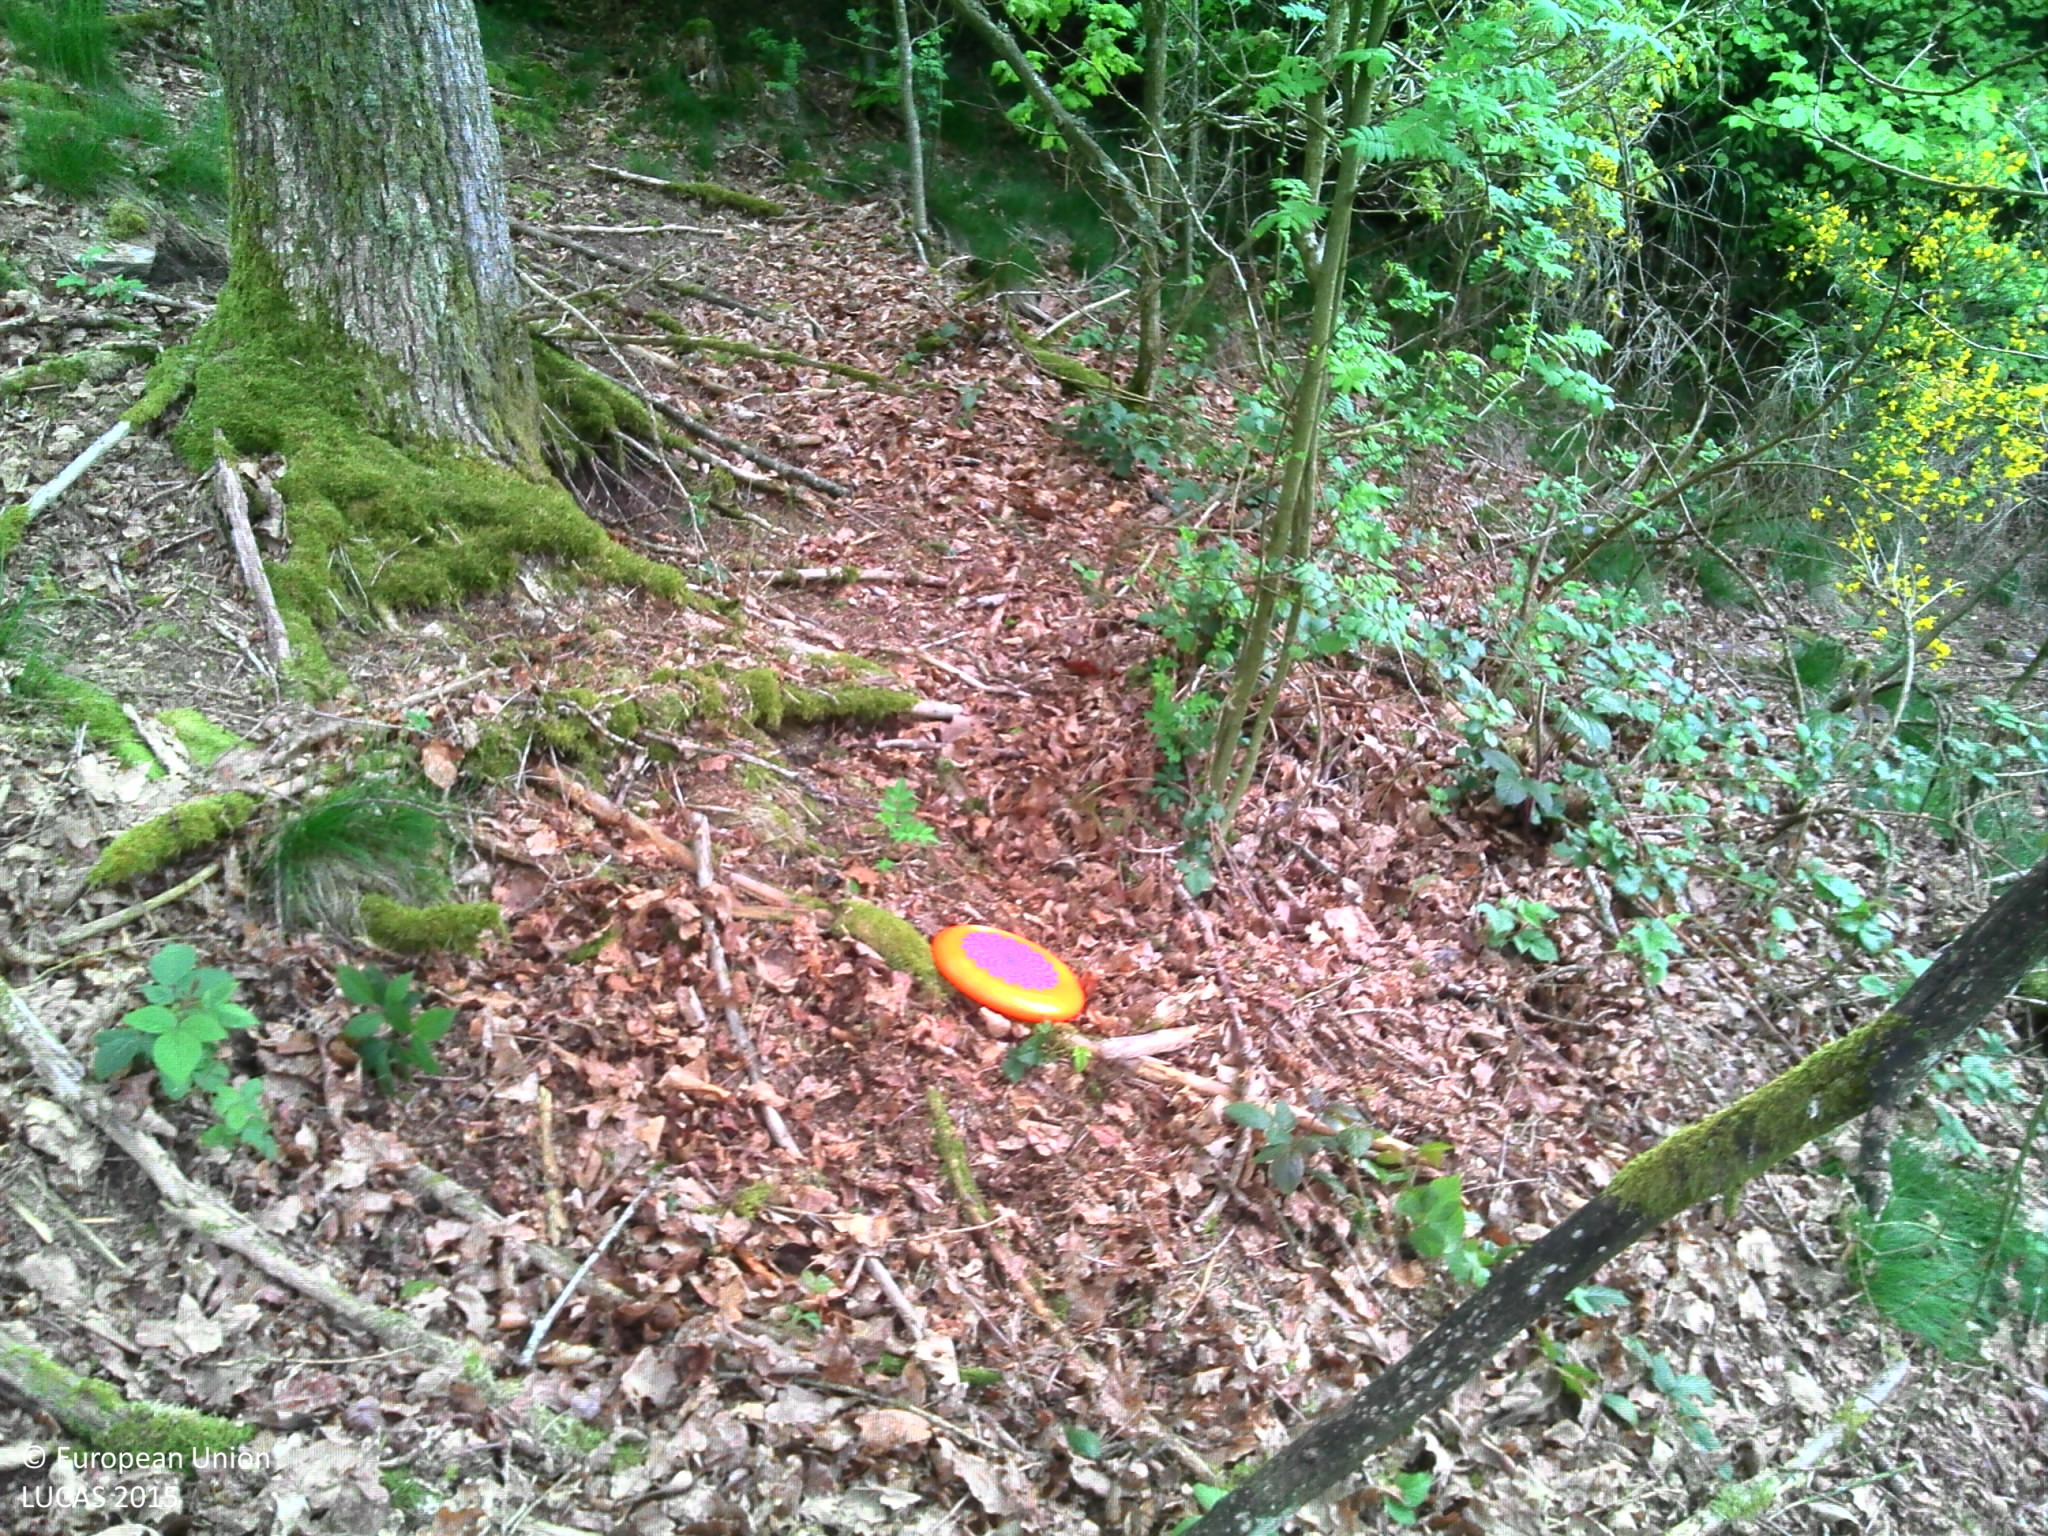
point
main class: Woodland
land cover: Broadleaved woodland
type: acidophilous oak and oak-birch forest
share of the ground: > 75 %
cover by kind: broadleaved forest trees 90 %, shrubs 5 %, herbaceous plants 5 %
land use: Forestry
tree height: > 5 m
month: May
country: LU
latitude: 50.0956
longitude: 5.9871
